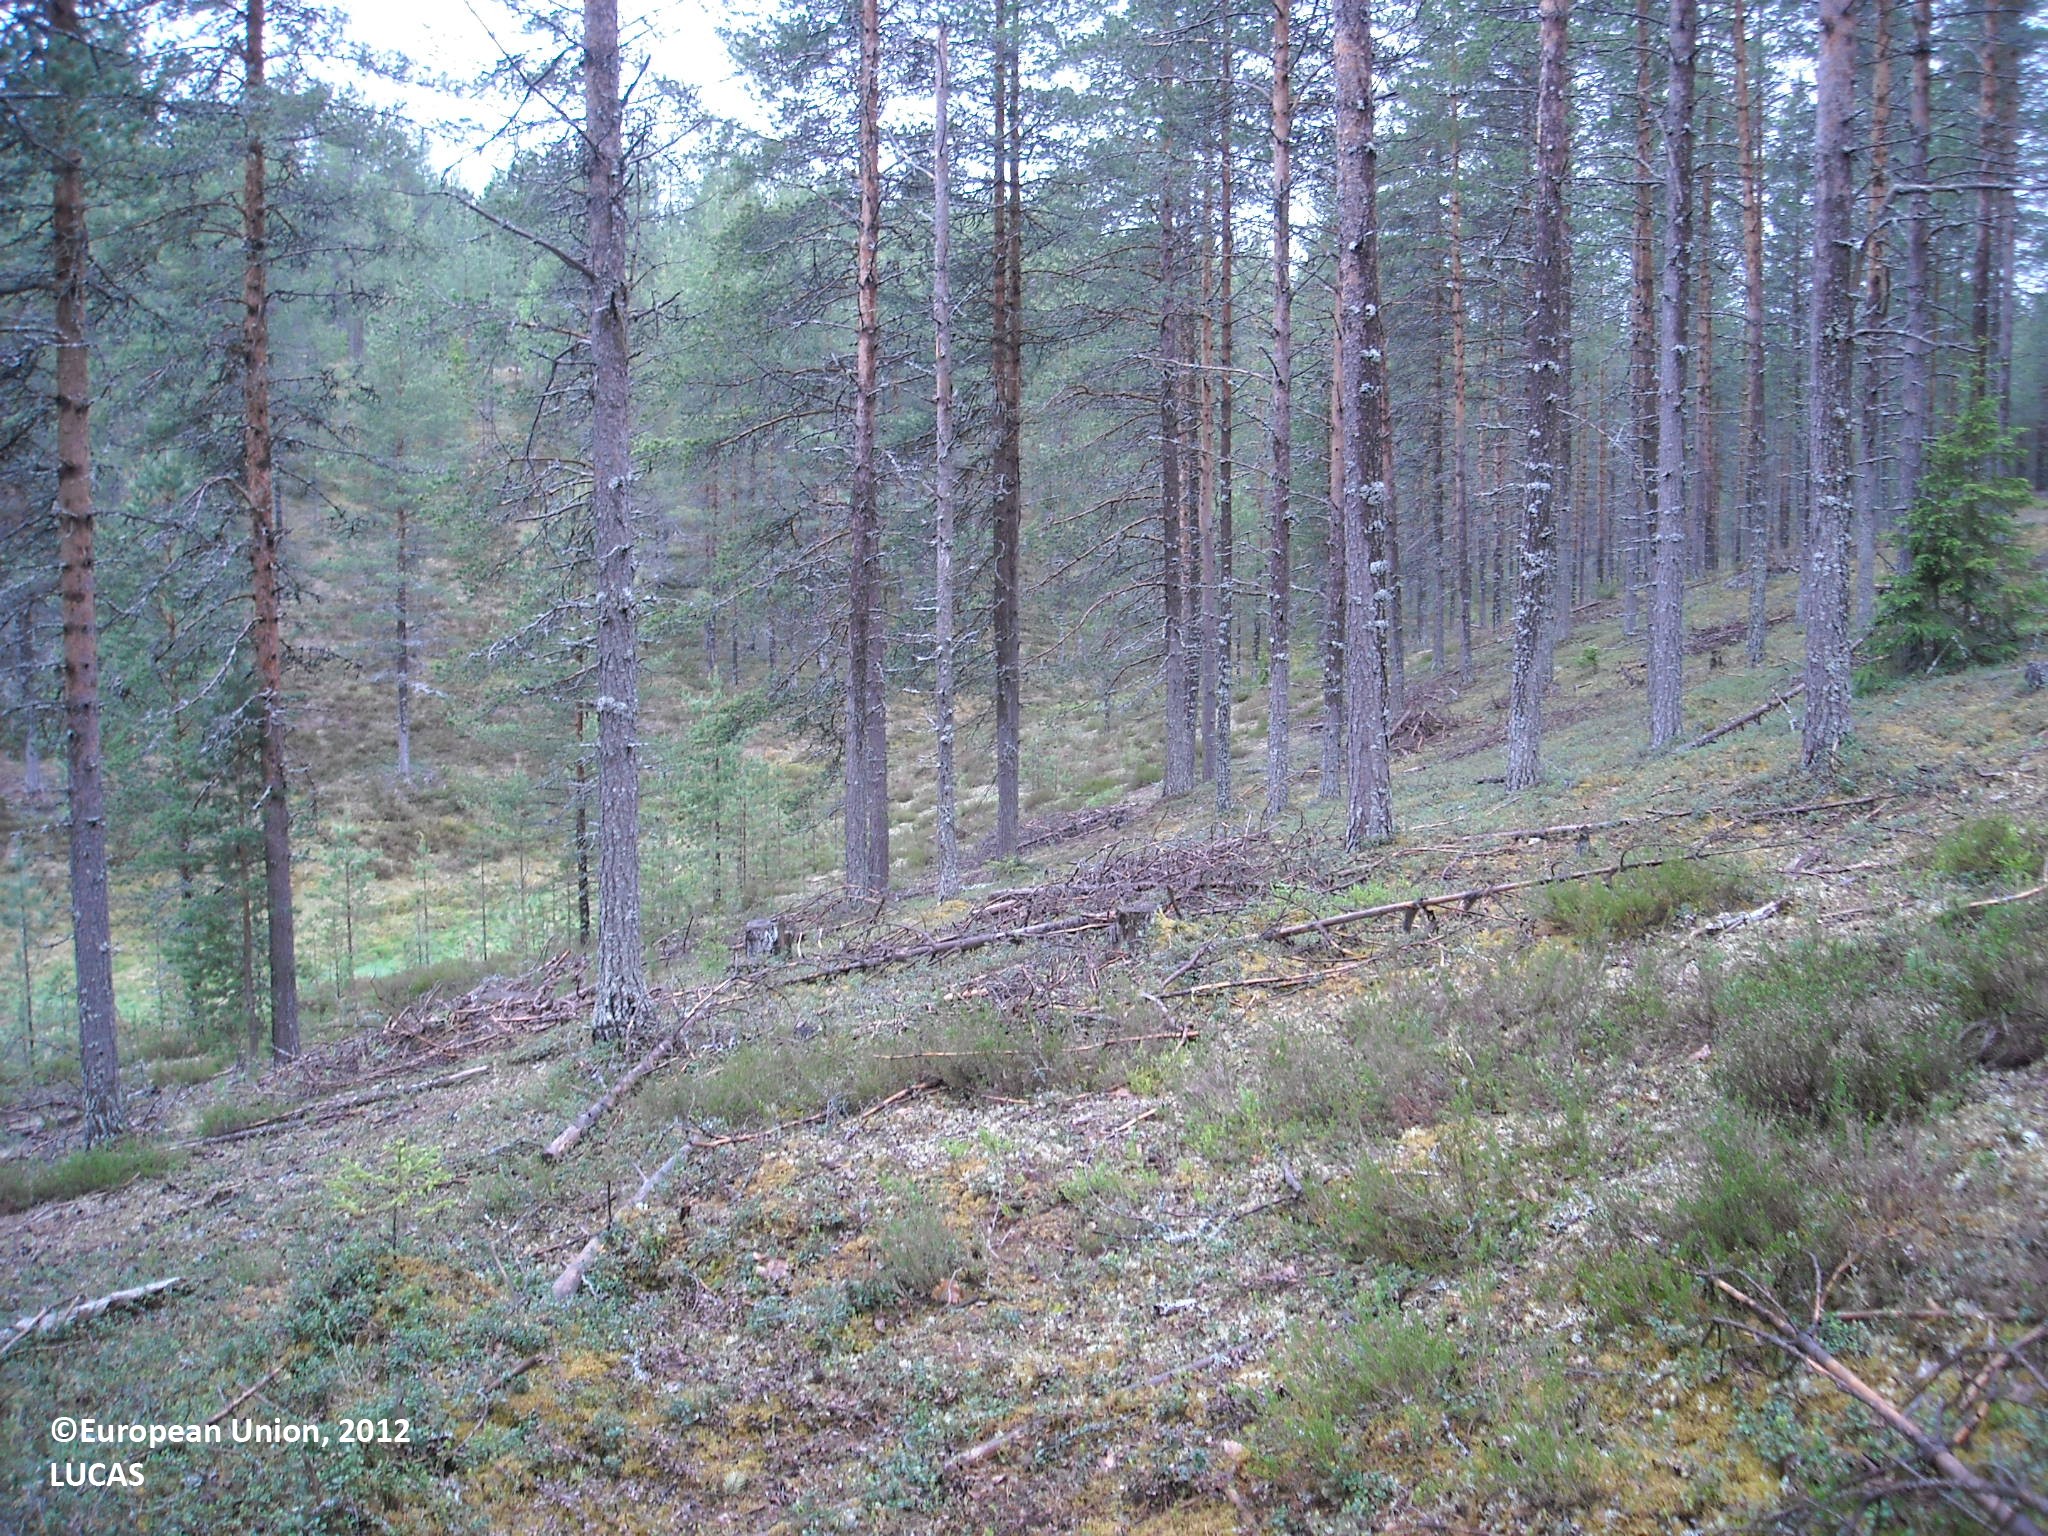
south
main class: Woodland
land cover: Pine dominated coniferous woodland
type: boreal forest
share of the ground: 50 - 75 %
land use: Forestry
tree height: > 5 m
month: June
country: FI
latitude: 65.5075
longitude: 27.9338
